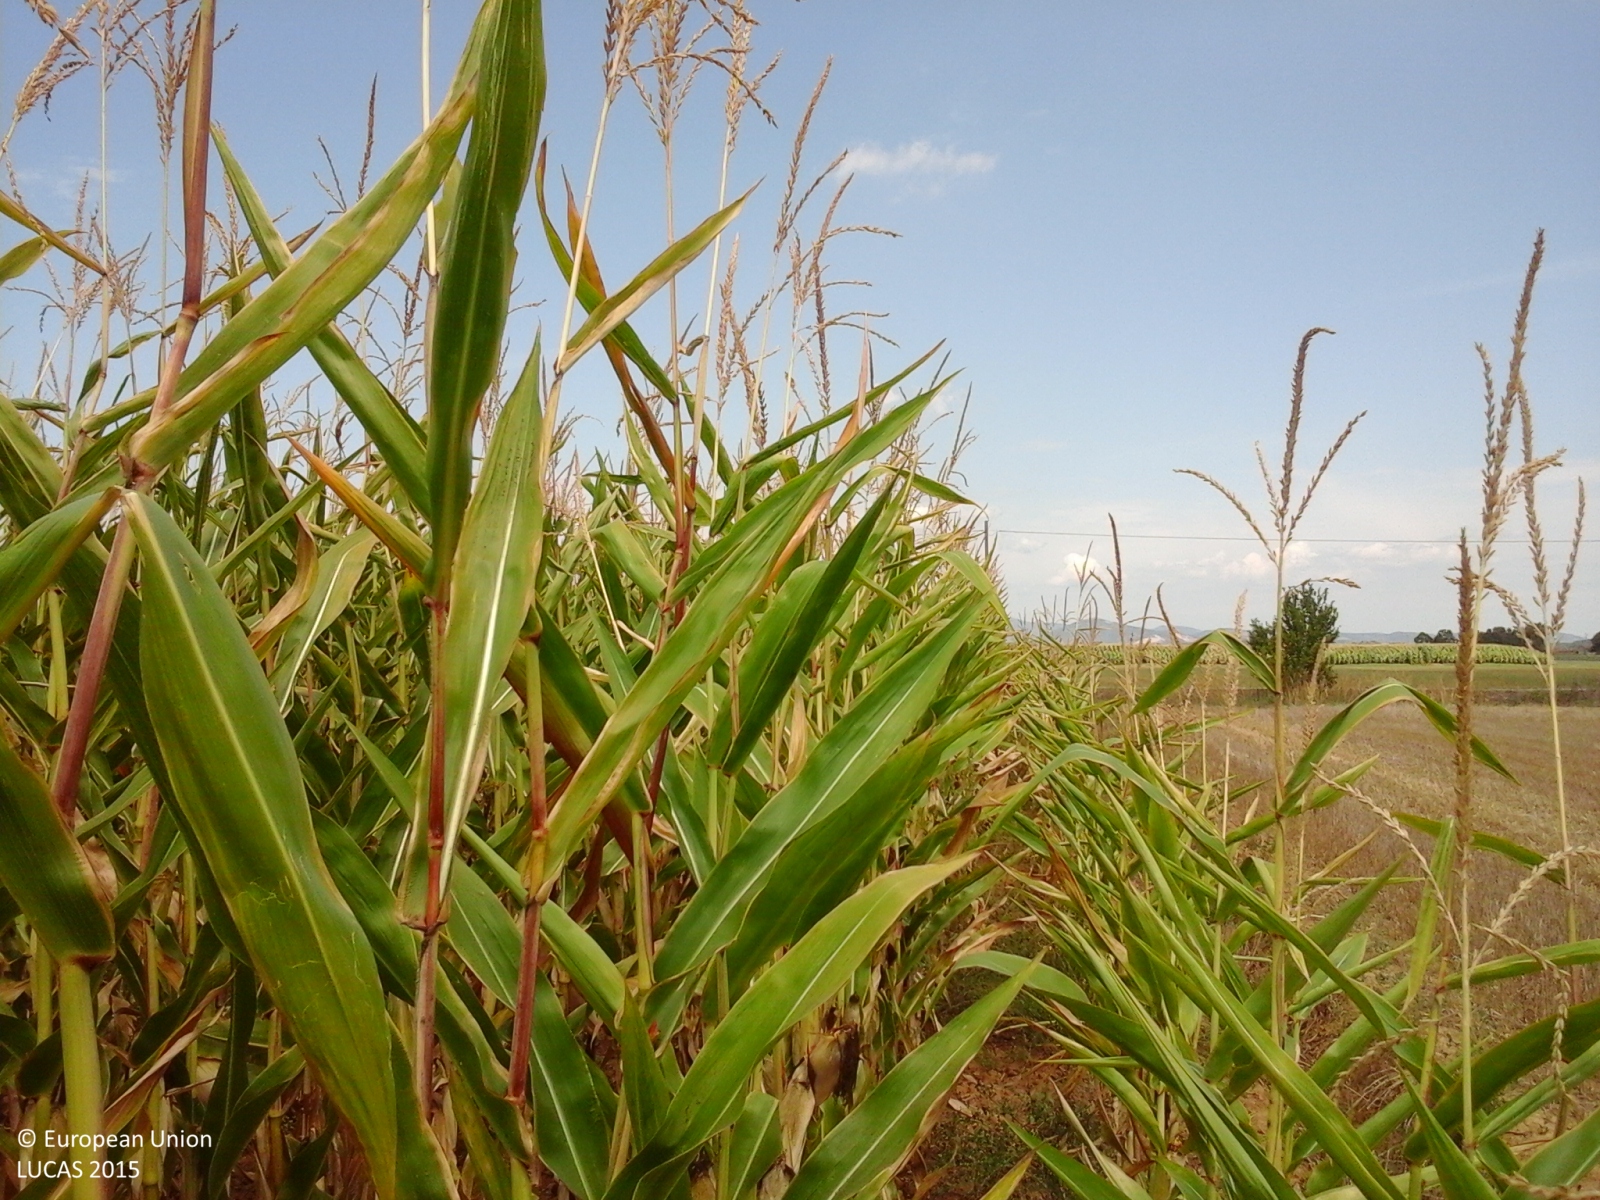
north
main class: Cropland
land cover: Maize
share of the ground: > 75 %
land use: Agriculture (excluding fallow land and kitchen gardens)
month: August
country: IT
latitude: 42.7022
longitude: 11.1072
